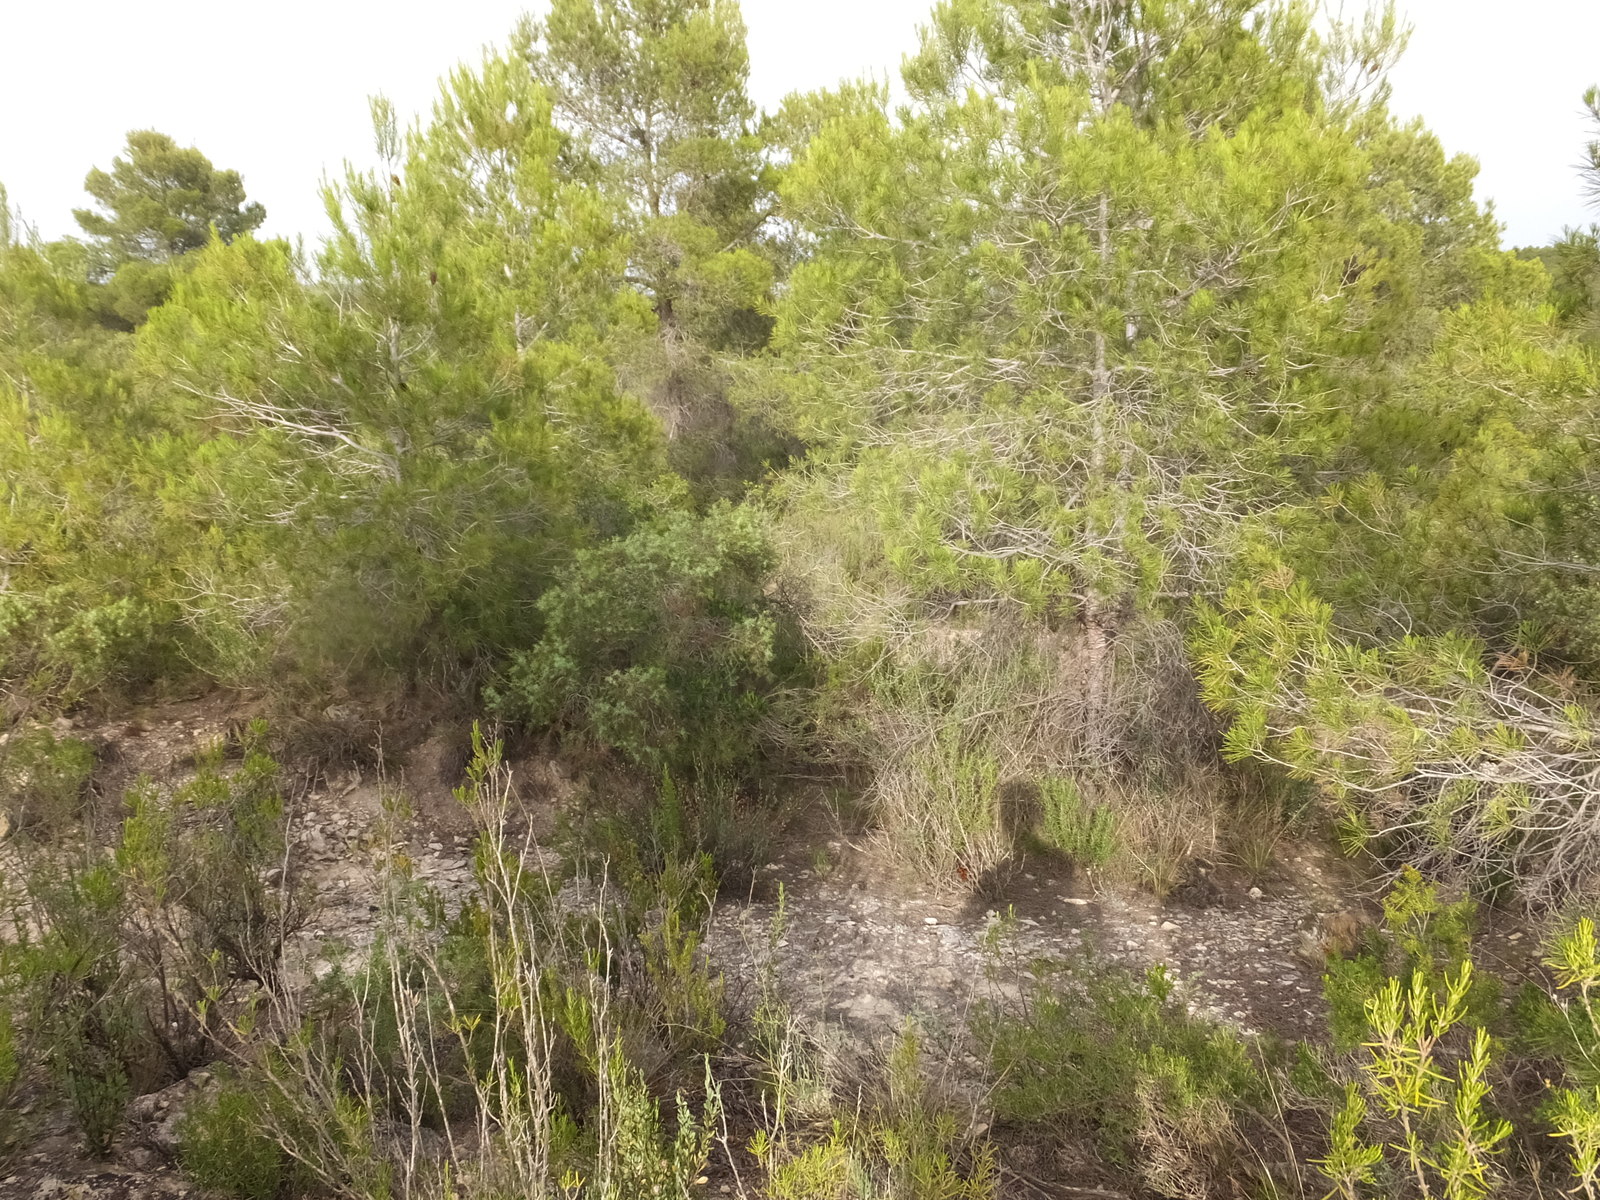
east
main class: Woodland
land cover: Pine dominated mixed woodland
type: coniferous forest of the mediterranean region
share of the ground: 50 - 75 %
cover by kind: coniferous forest trees 50 %, shrubs 30 %, broadleaved forest trees 20 %
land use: Forestry
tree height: < 5 m
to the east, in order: Pine dominated mixed woodland; Olive groves; Pine dominated mixed woodland
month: July
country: ES
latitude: 41.3330
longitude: 0.4900
